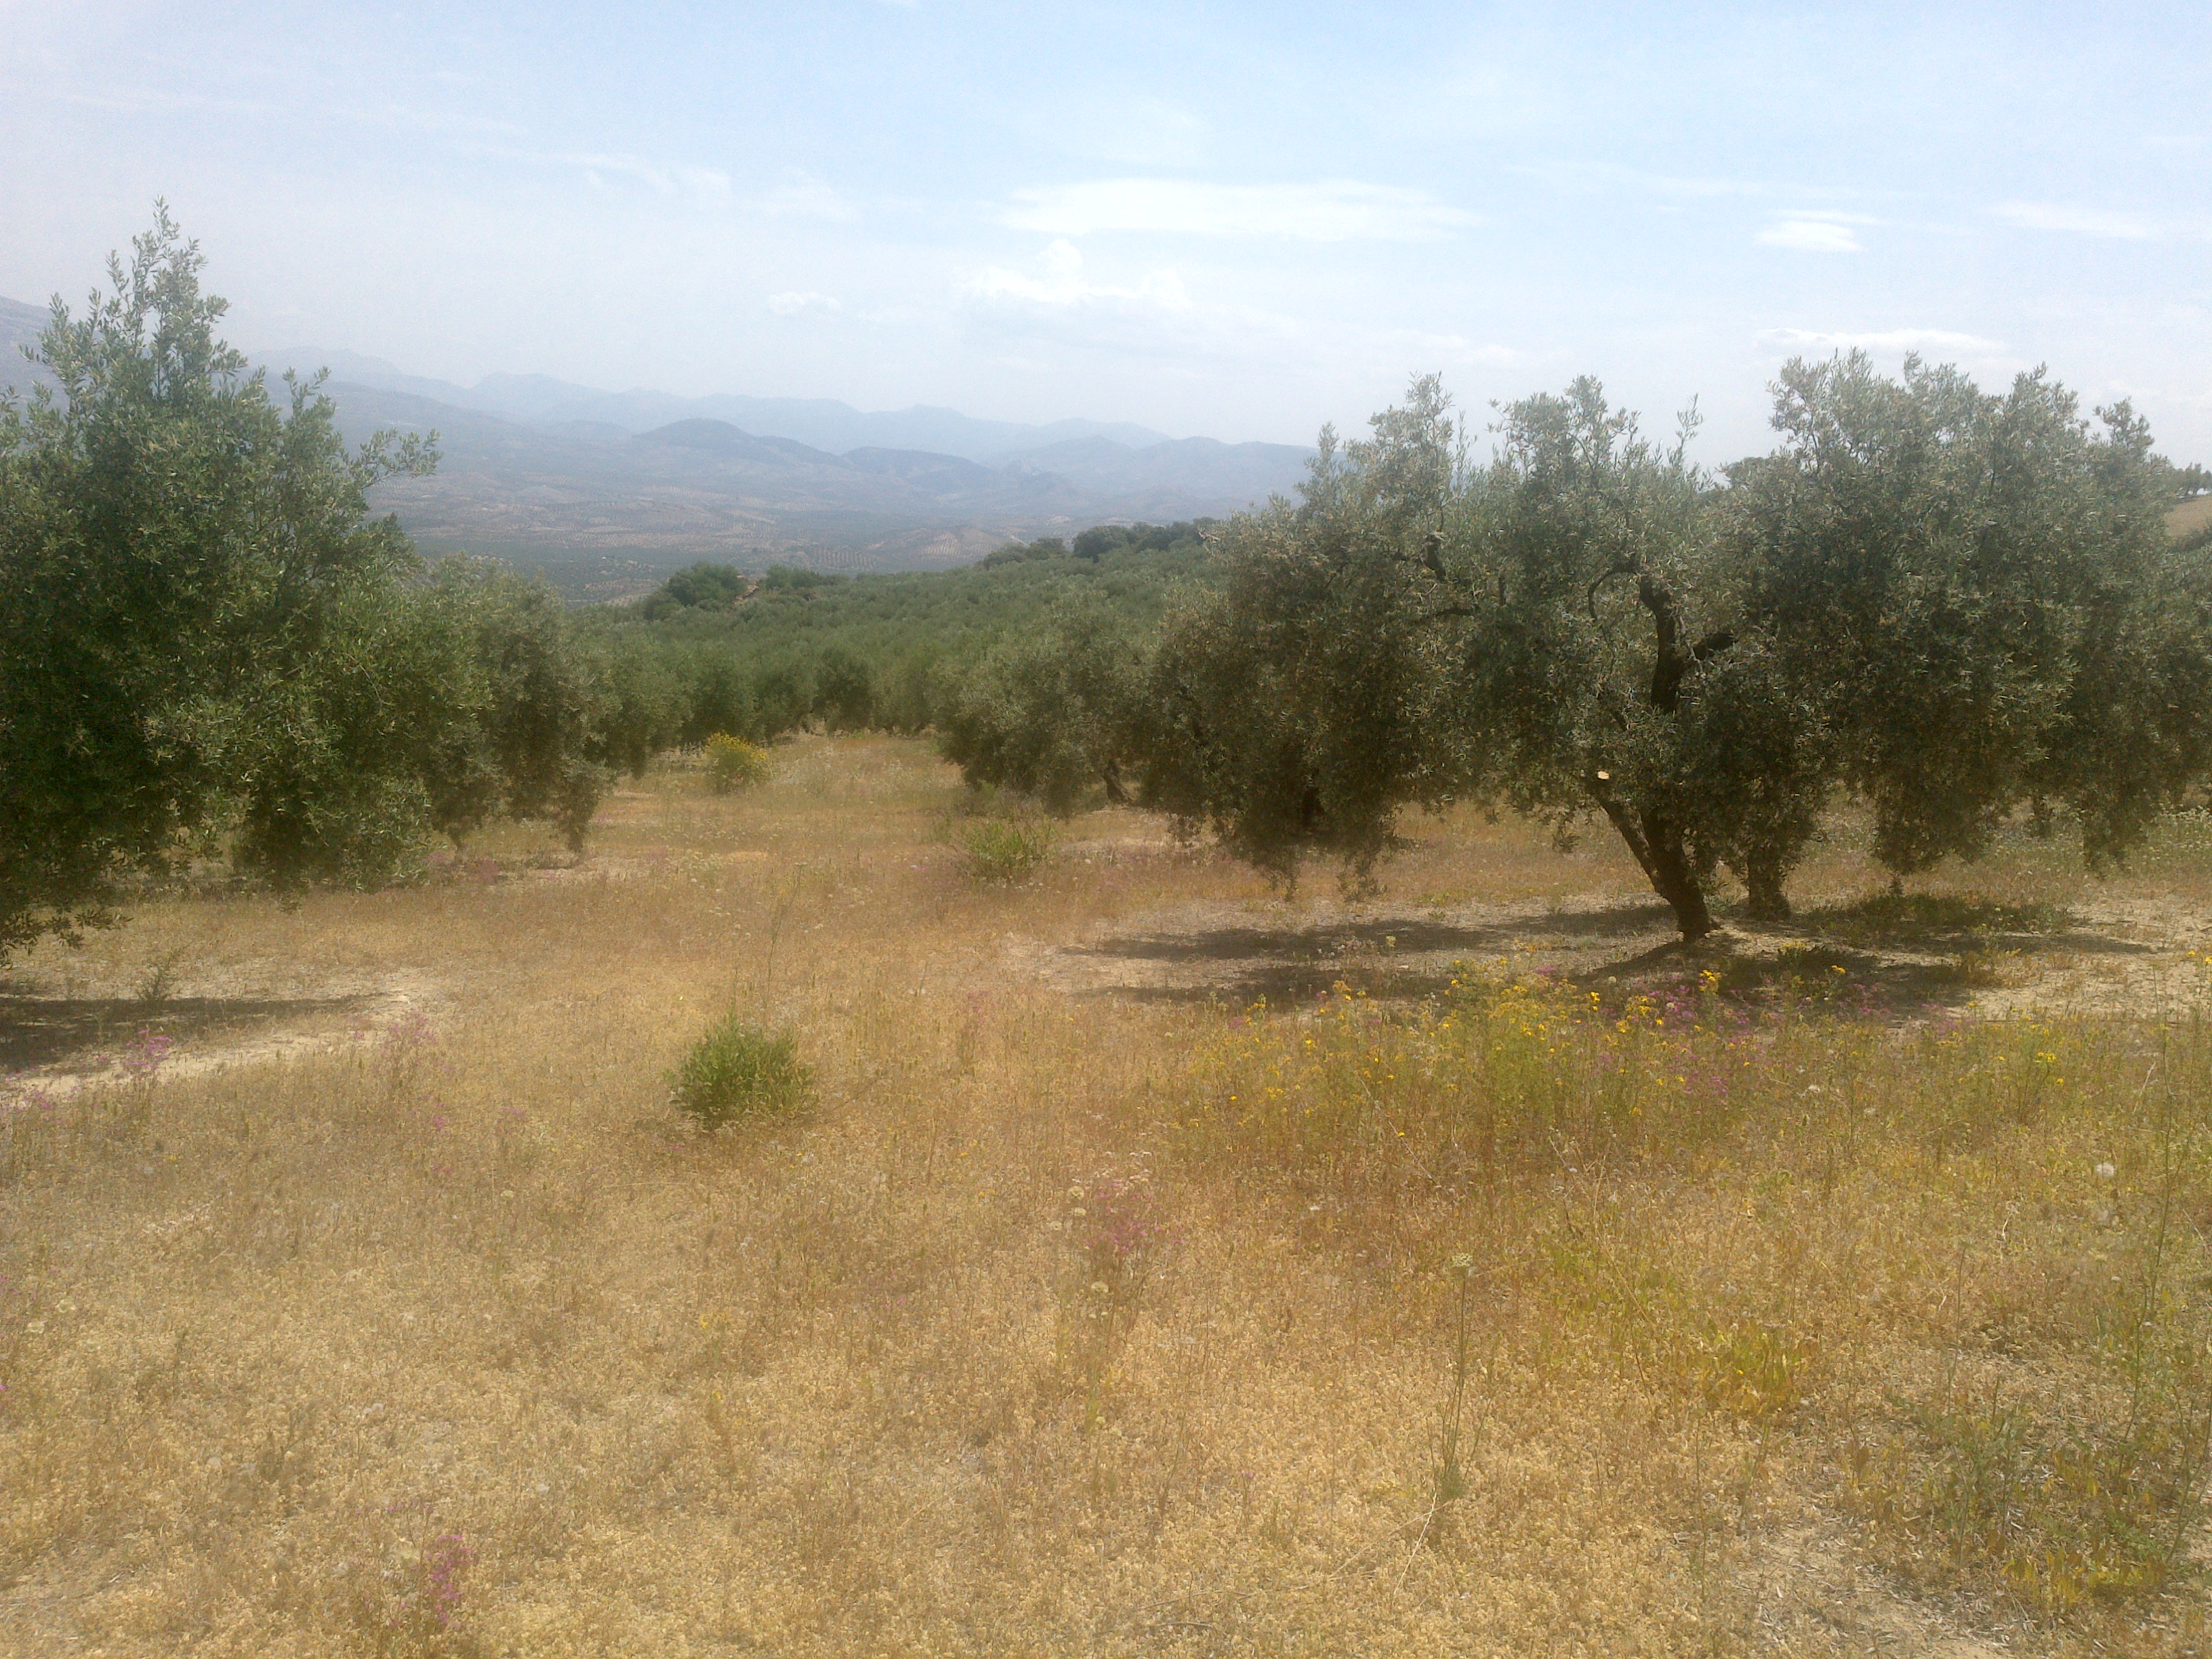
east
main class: Cropland
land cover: Olive groves
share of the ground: 50 - 75 %
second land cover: Spontaneously vegetated surfaces
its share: 50 - 75 %
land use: Agriculture (excluding fallow land and kitchen gardens)
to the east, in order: Olive groves; Spontaneously vegetated surfaces; Grass margins; Other structural elements; Grass margins; Olive groves; Tracks; Olive groves
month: May
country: ES
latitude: 37.5391
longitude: -4.2049
